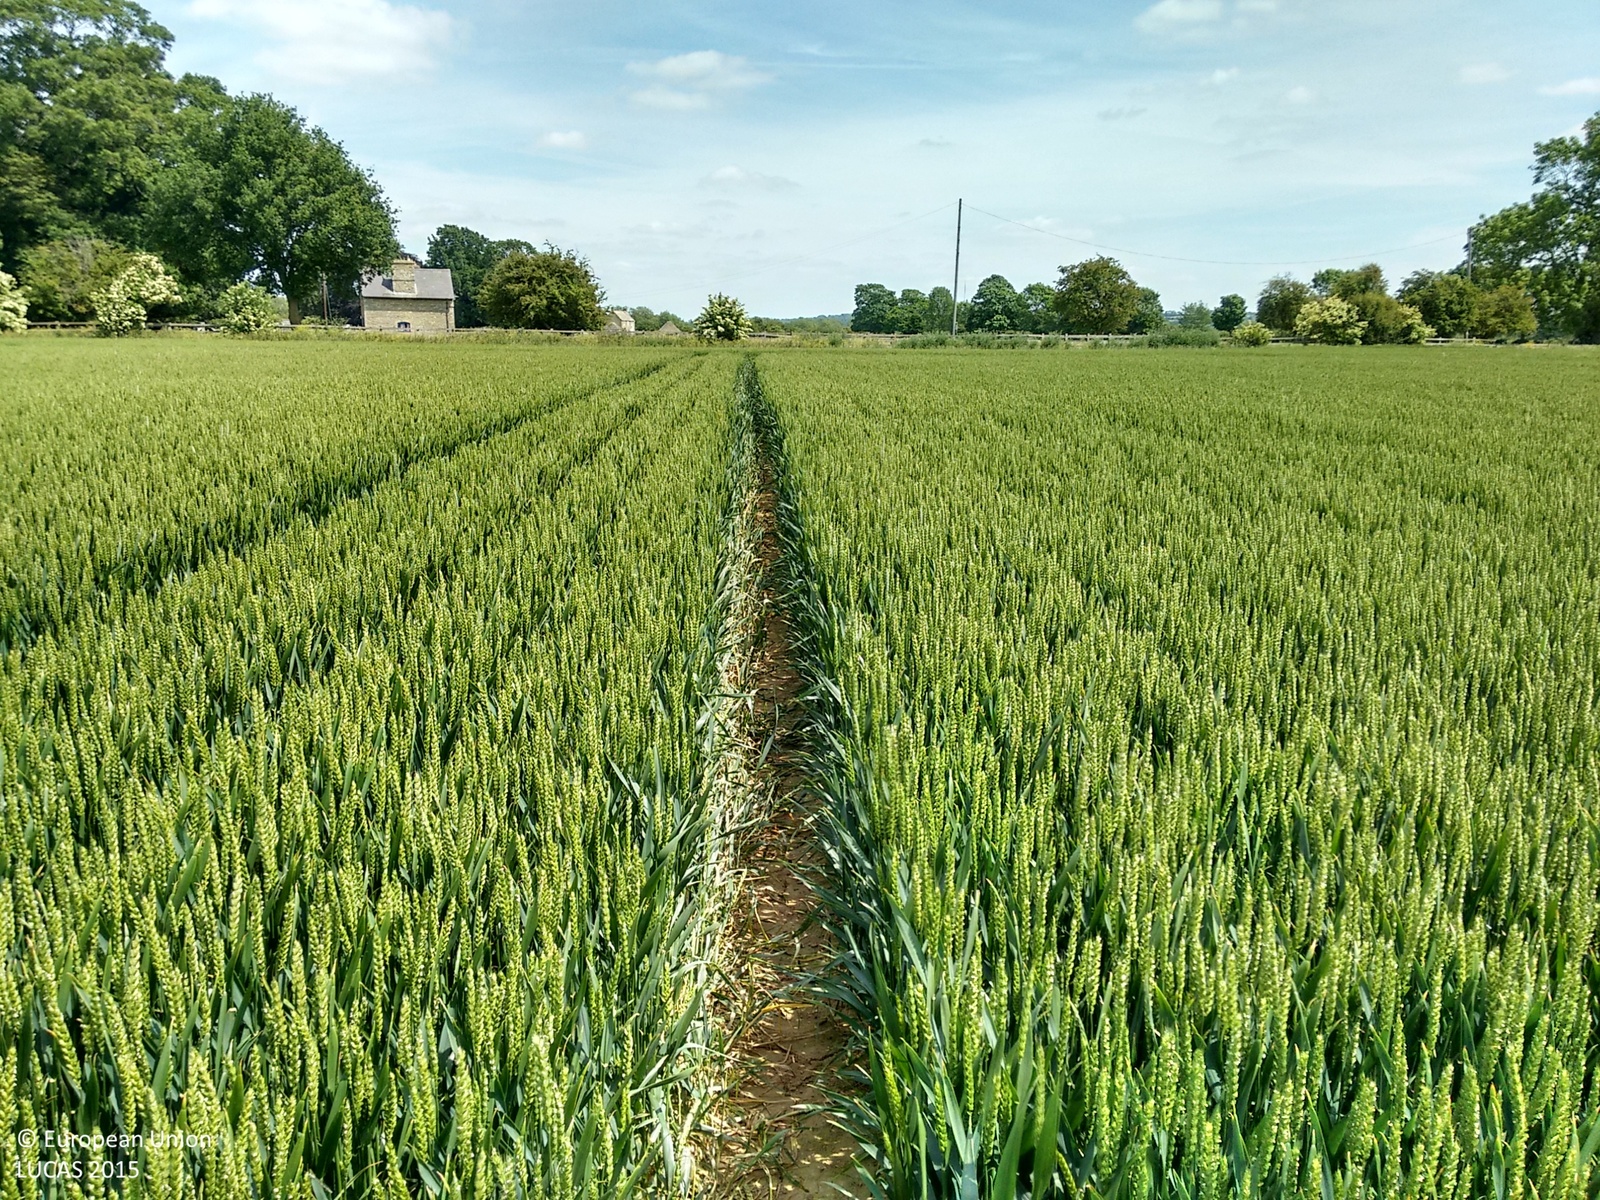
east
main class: Cropland
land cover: Common wheat
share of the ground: > 75 %
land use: Agriculture (excluding fallow land and kitchen gardens)
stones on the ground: < 10 %
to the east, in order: Common wheat; Grass margins; Fences; Grass margins; Tracks; Grass margins; Electric lines; Fences; Grassland without tree/shrub cover
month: June
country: GB
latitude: 51.8037
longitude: -1.2581
